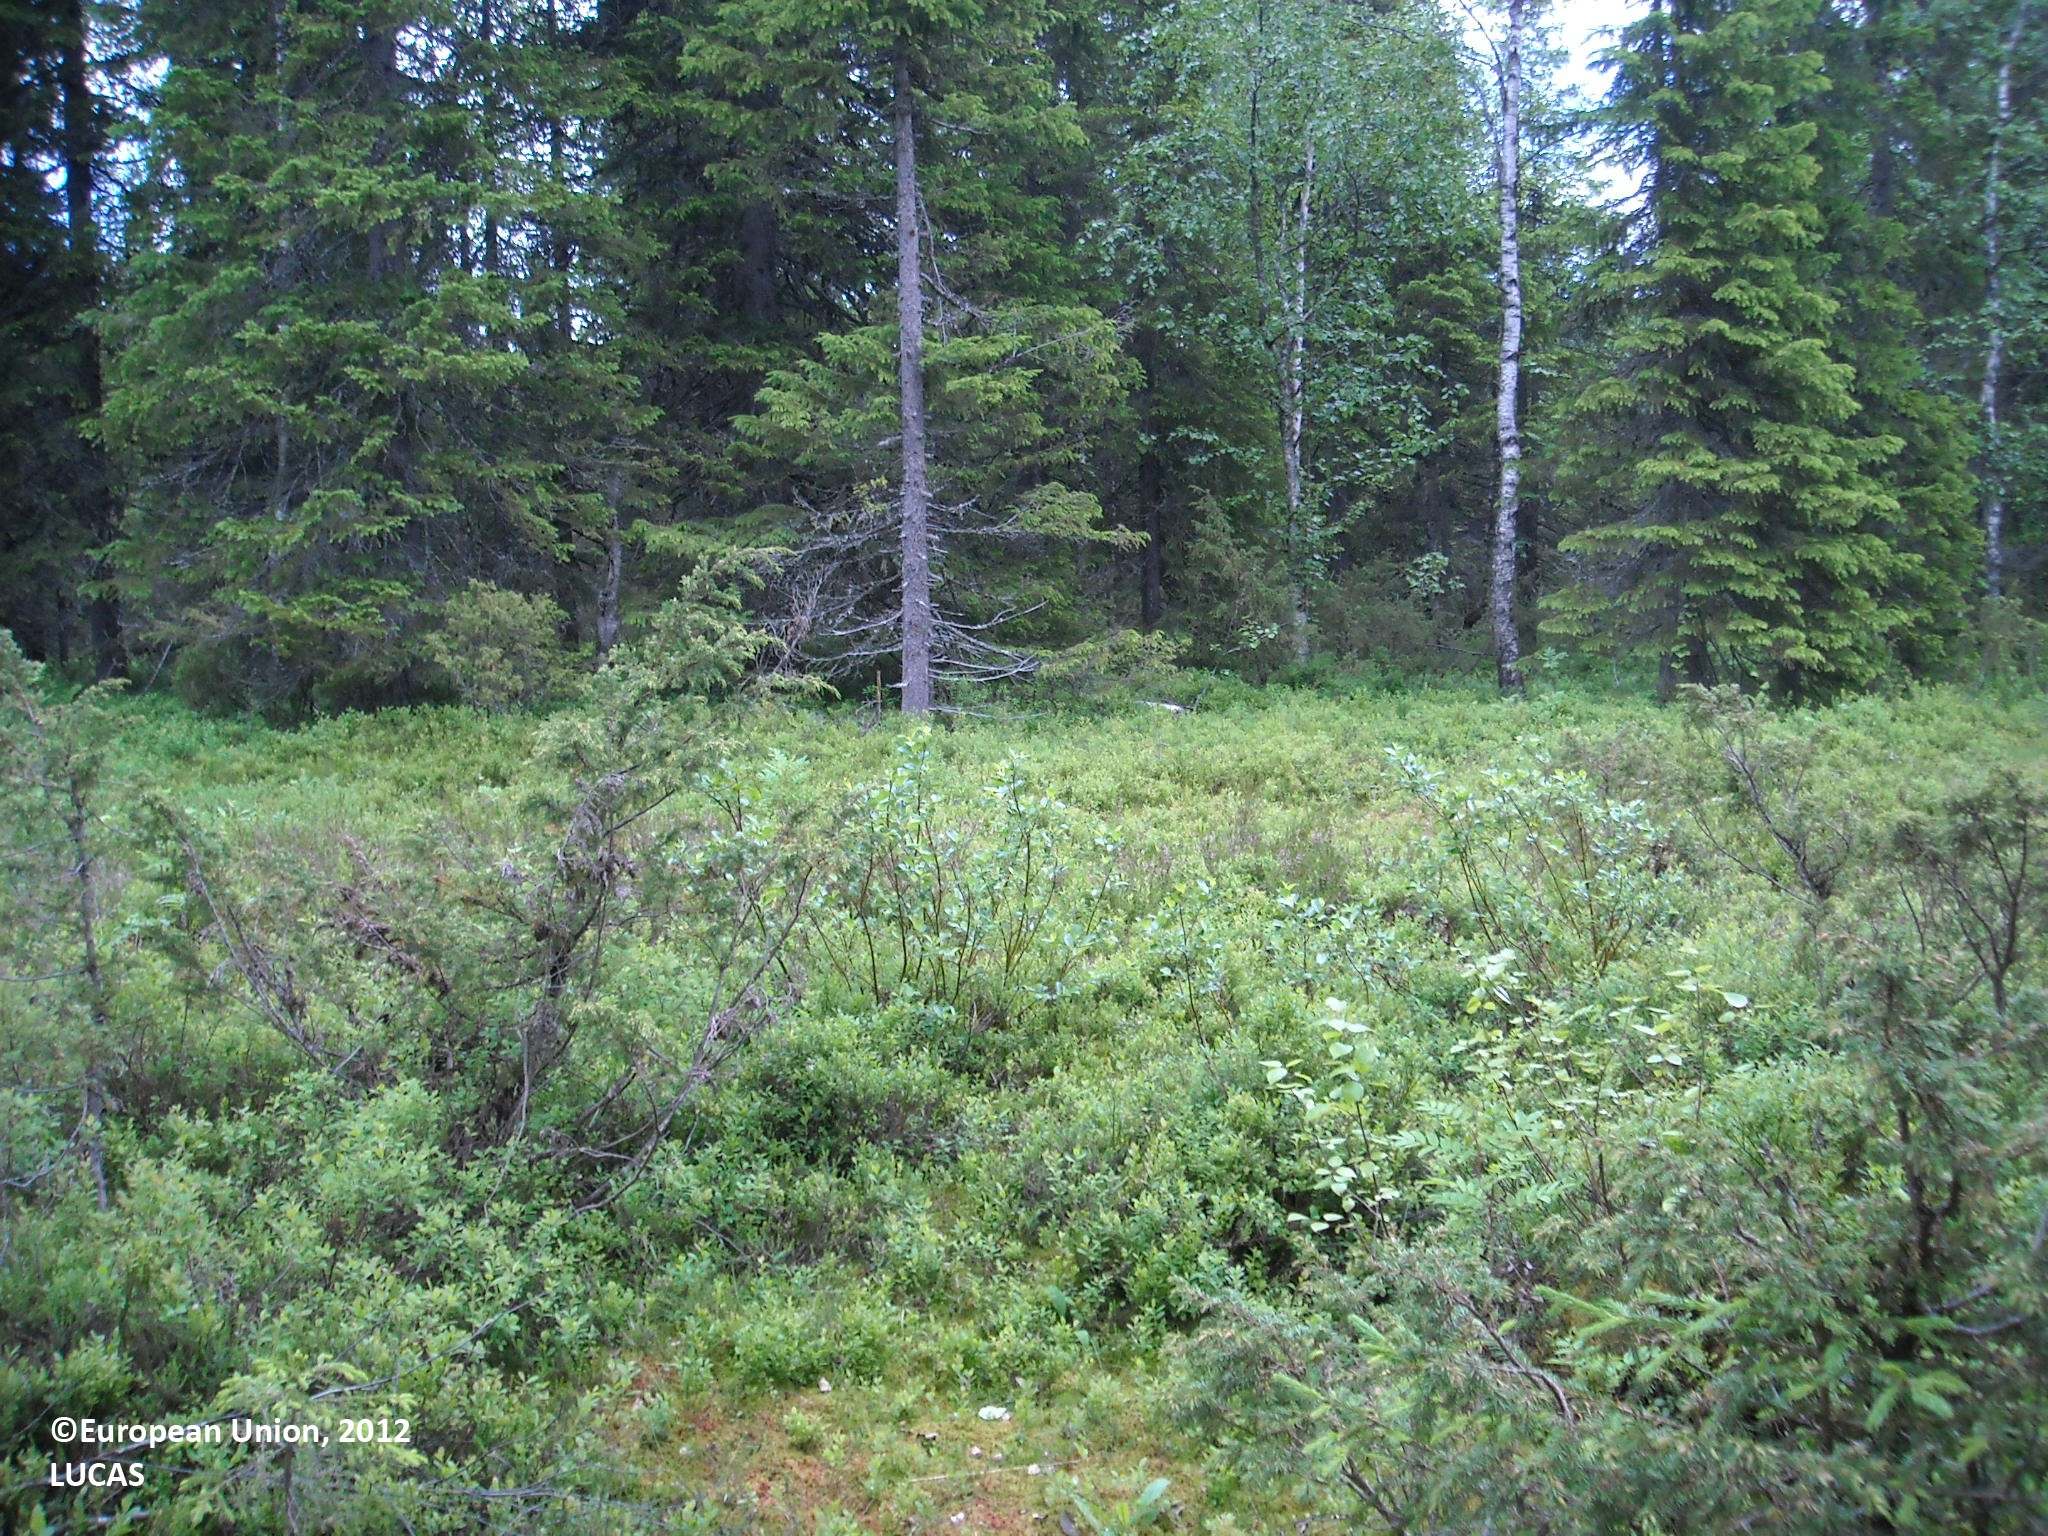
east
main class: Woodland
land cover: Spruce dominated mixed woodland
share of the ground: > 75 %
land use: Forestry
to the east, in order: Spruce dominated mixed woodland; Shrubland without tree cover; Electric lines; Shrubland without tree cover; Spruce dominated mixed woodland; Other mixed woodland; Spruce dominated coniferous woodland; Other coniferous woodland
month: July
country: FI
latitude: 64.9894
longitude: 27.8917
